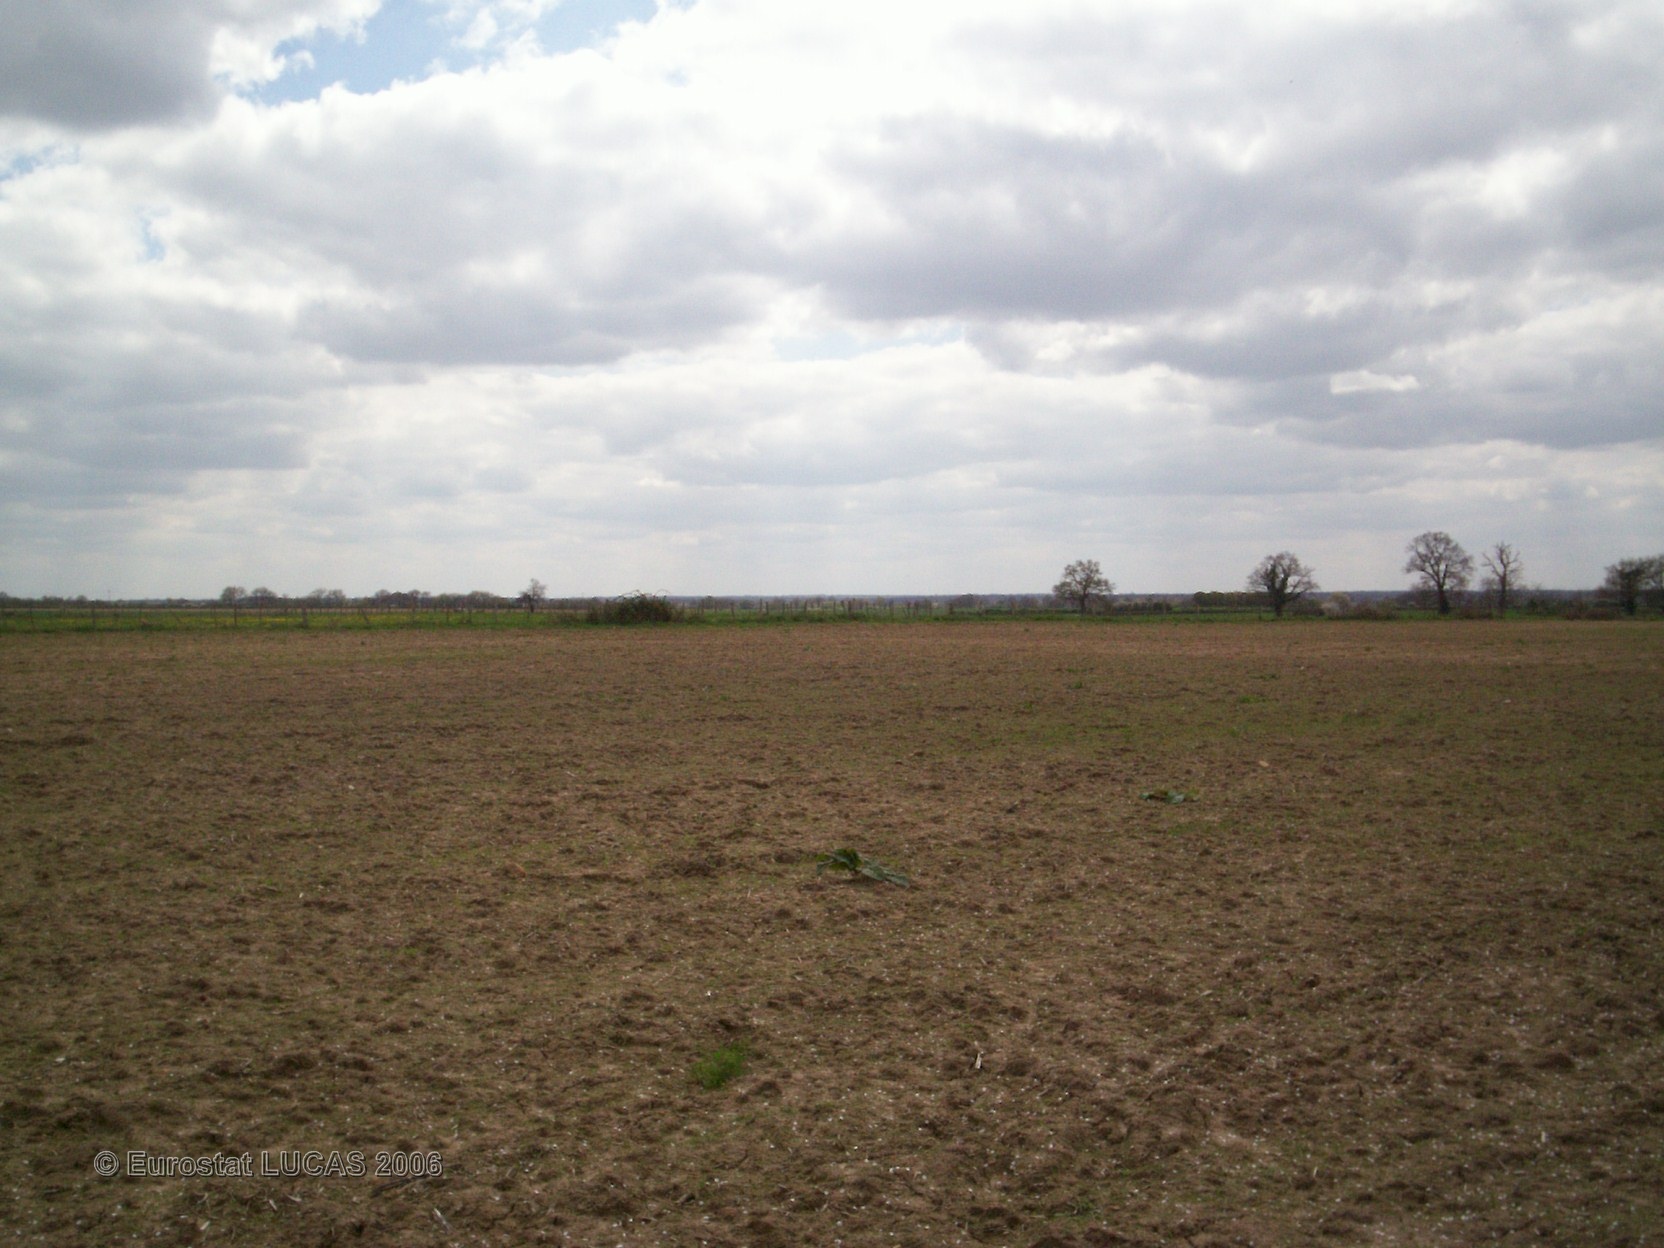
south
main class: Grassland
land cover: Grassland without tree/shrub cover
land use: Agriculture (excluding fallow land and kitchen gardens)
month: April
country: FR
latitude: 46.1849
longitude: 0.5396
